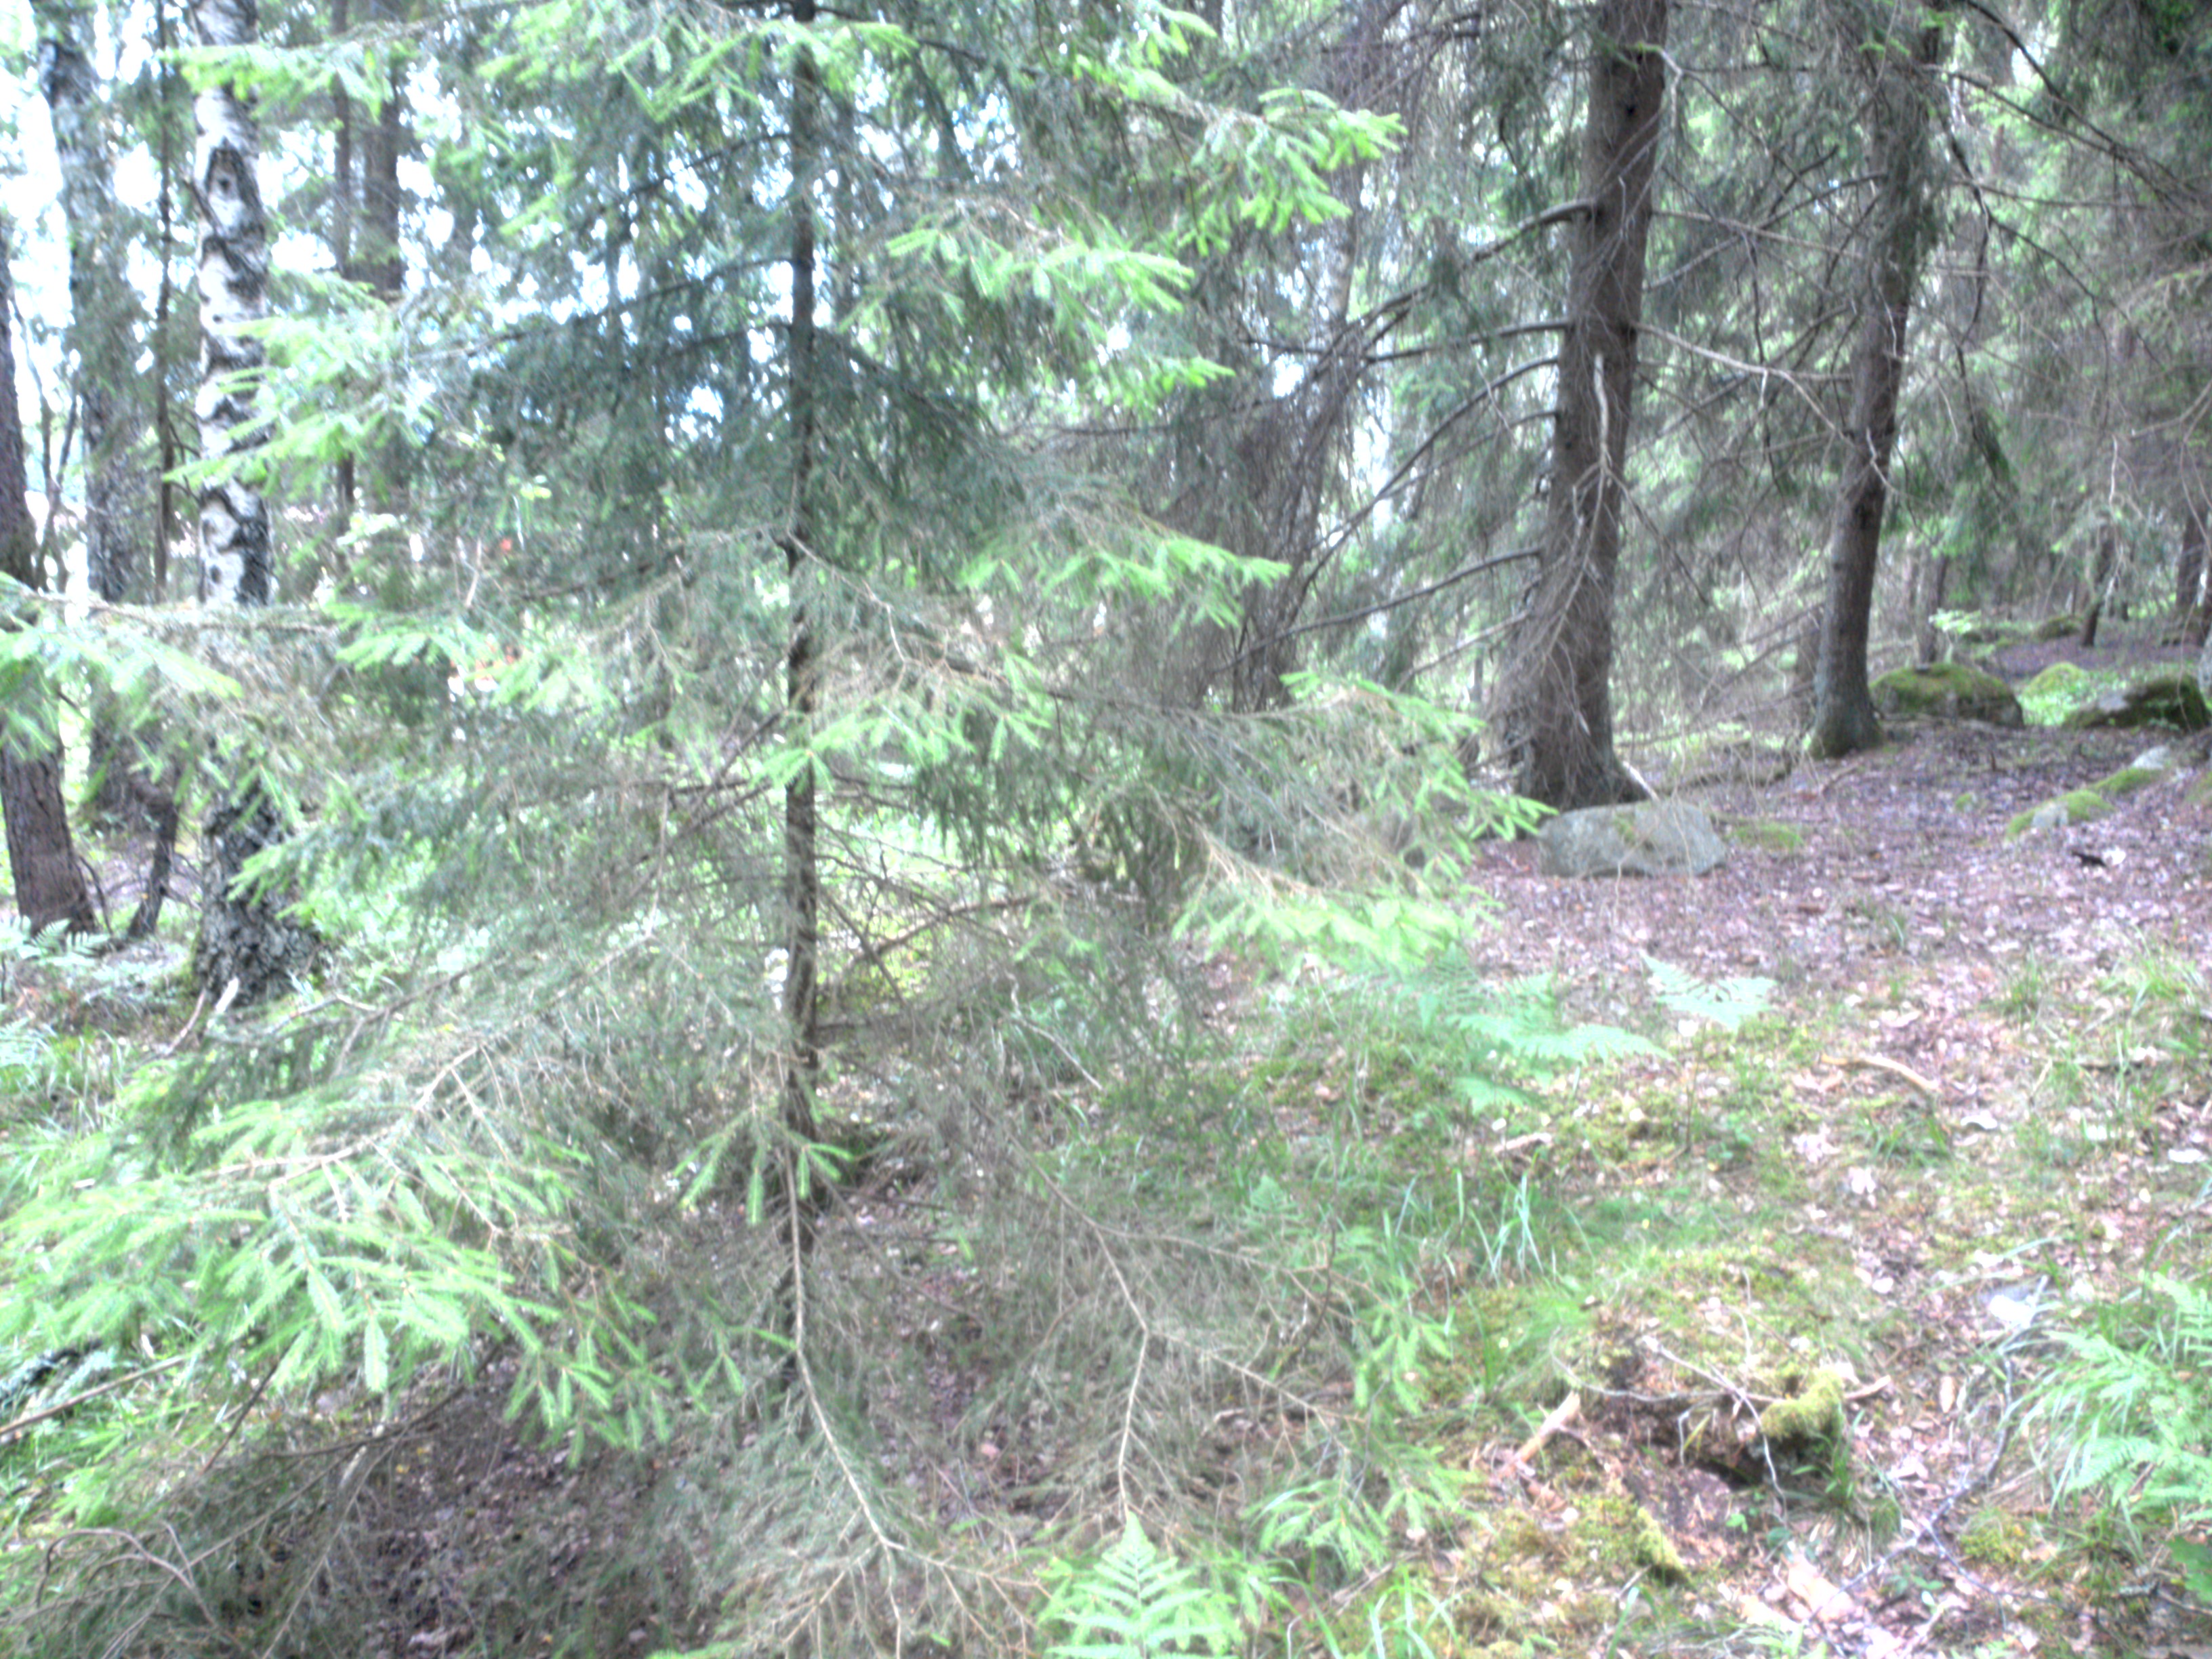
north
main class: Woodland
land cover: Spruce dominated mixed woodland
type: boreal forest
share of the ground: 50 - 75 %
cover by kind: coniferous forest trees 50 %, broadleaved forest trees 20 %, lichens and mosses 20 %, herbaceous plants 10 %
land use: Forestry
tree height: > 5 m
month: June
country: SE
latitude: 59.4215
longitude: 17.8042
